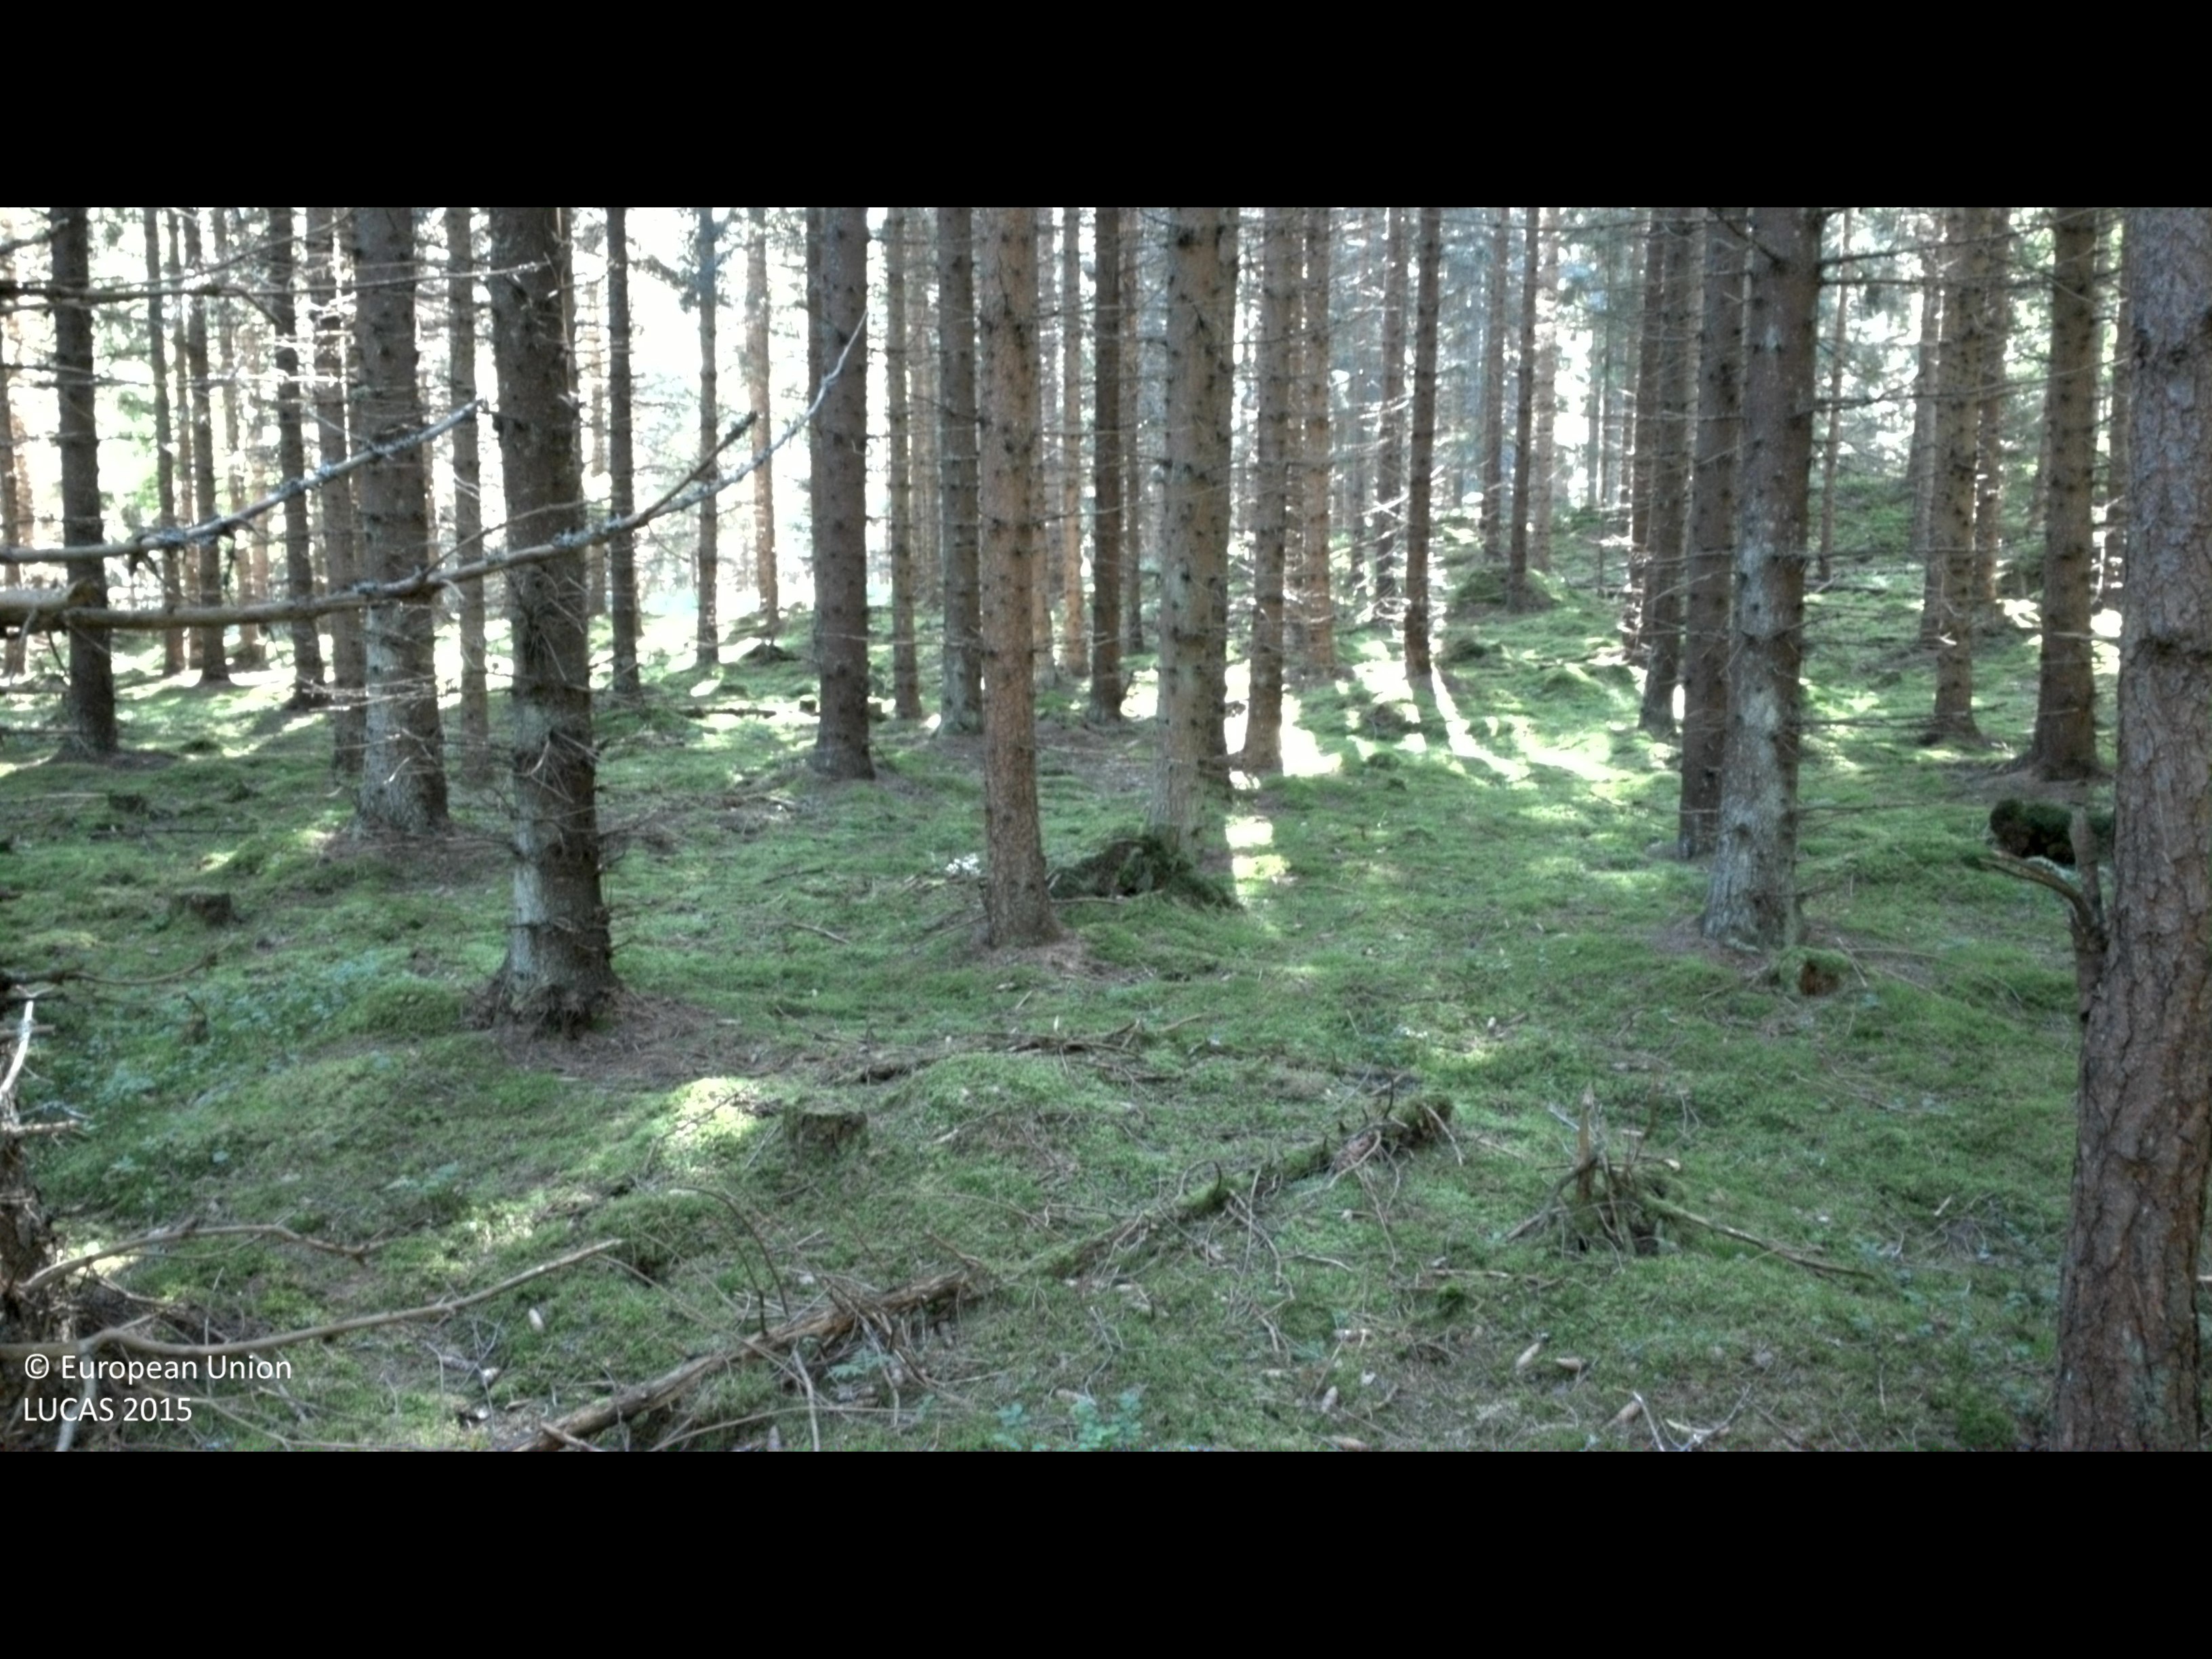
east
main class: Woodland
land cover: Spruce dominated coniferous woodland
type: boreal forest
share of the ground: > 75 %
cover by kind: coniferous forest trees 85 %, lichens and mosses 10 %, shrubs 5 %
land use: Forestry
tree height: > 5 m
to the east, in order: Spruce dominated coniferous woodland; Grass margins; Paved roads, cycling and walking lanes; Grass margins; Spruce dominated coniferous woodland; Spruce dominated mixed woodland; Rocks and stones; Shrubland with sparse tree cover; Lichens and moss; Other coniferous woodland
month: July
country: SE
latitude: 58.2009
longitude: 16.2408
